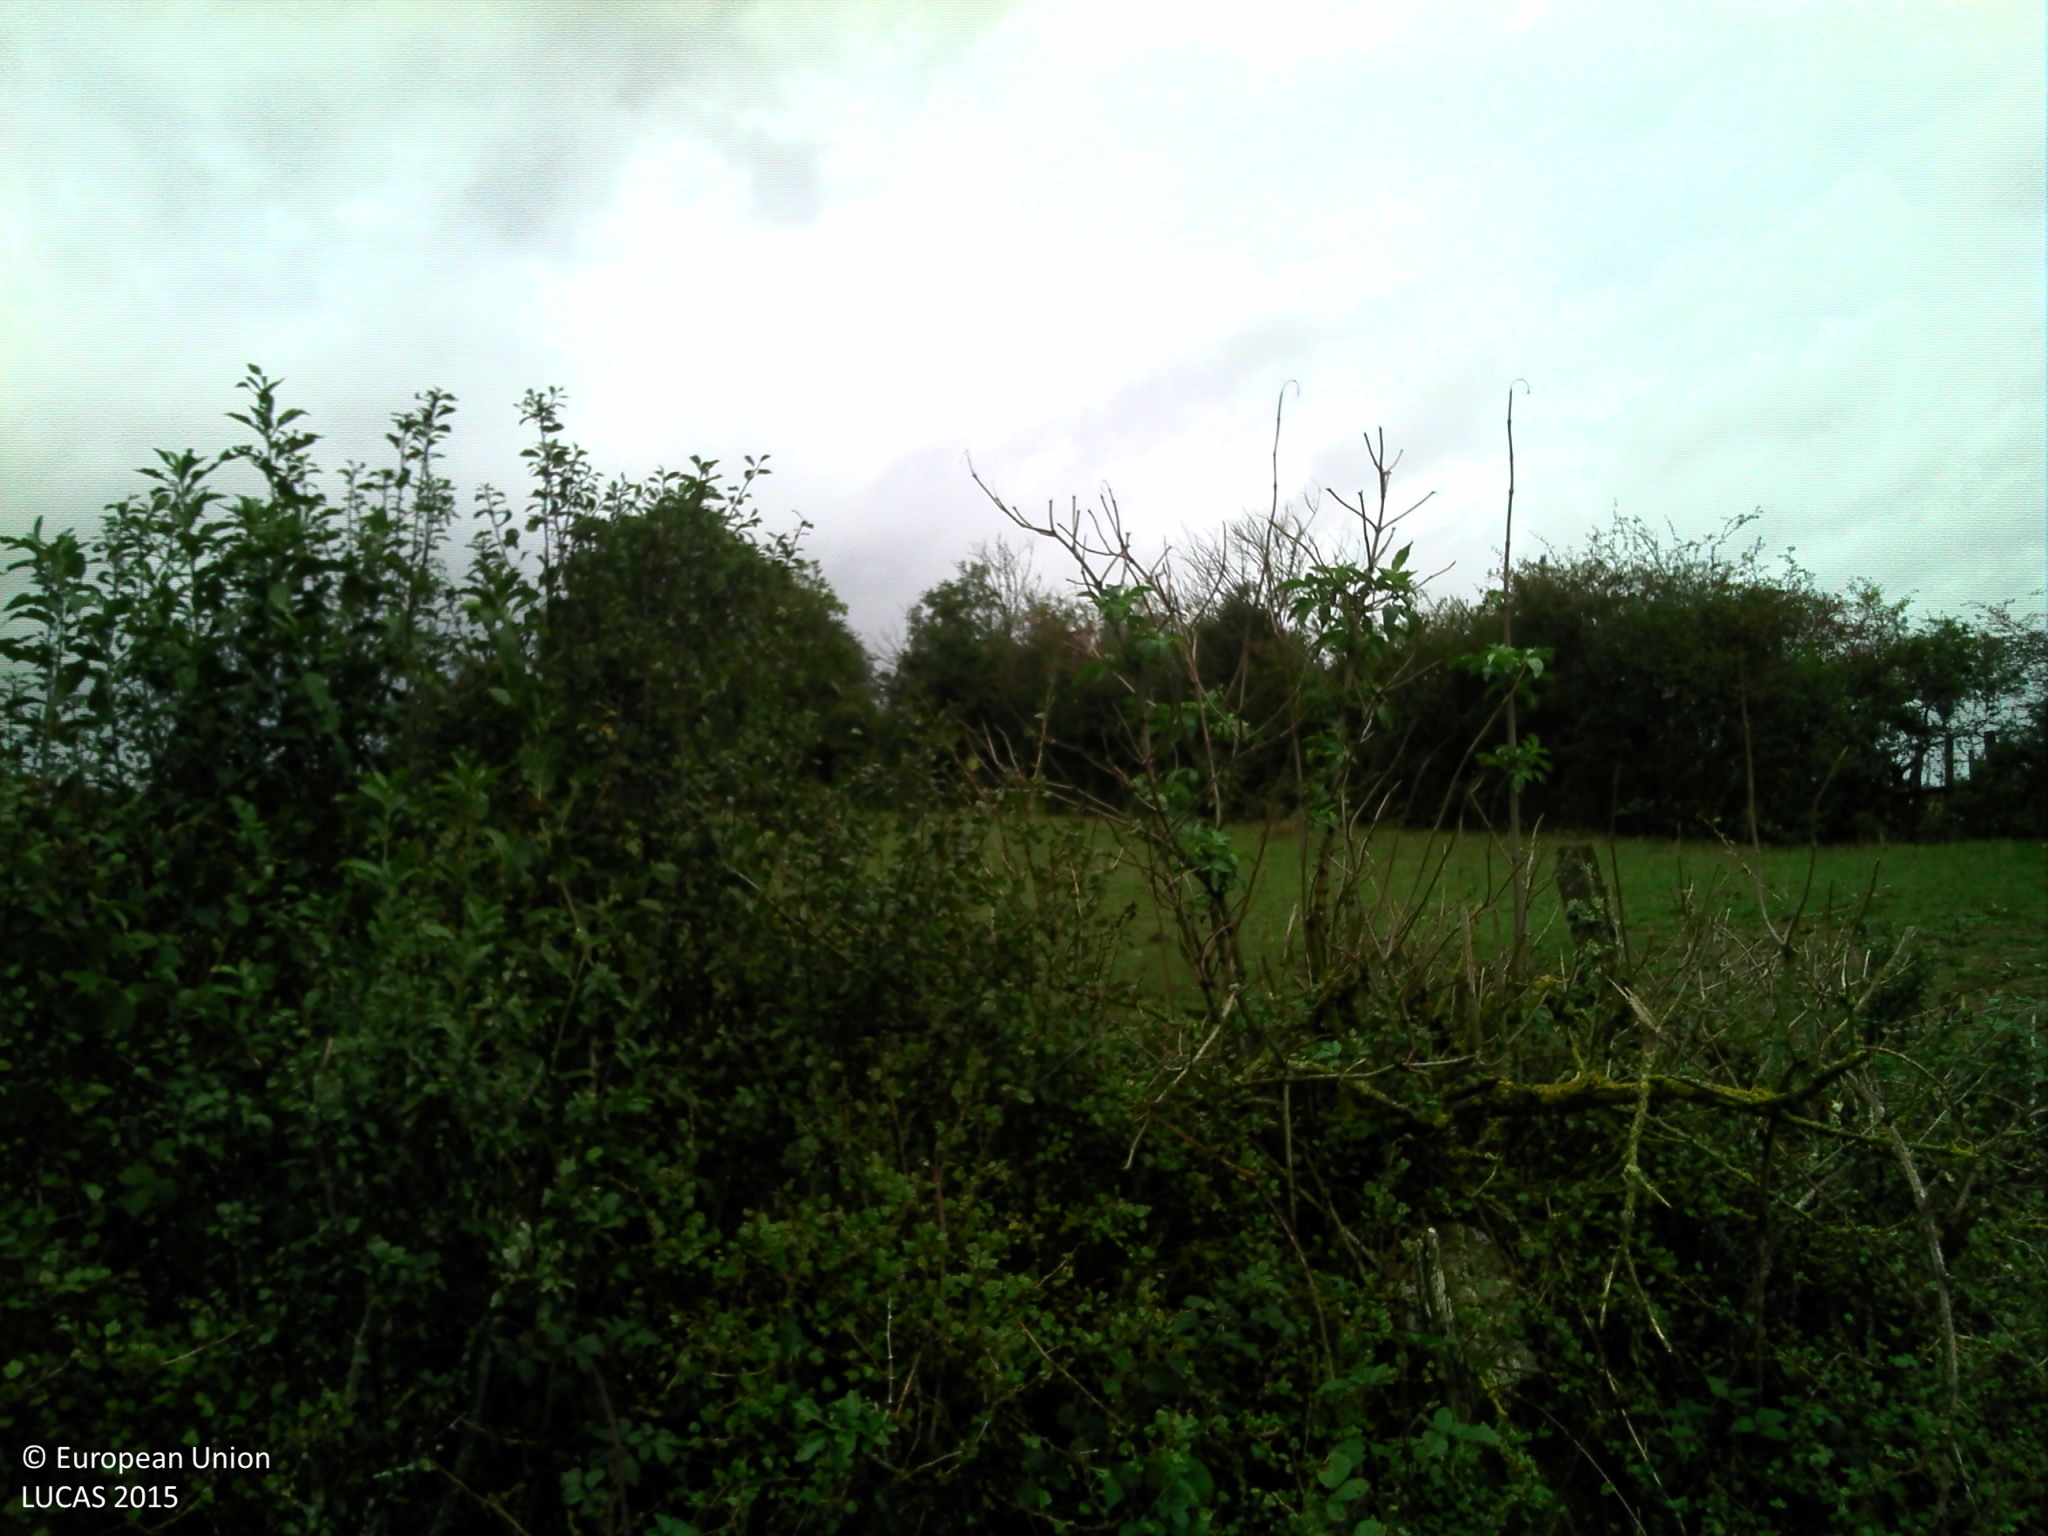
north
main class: Grassland
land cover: Grassland without tree/shrub cover
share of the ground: > 75 %
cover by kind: herbaceous plants 100 %
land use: Agriculture (excluding fallow land and kitchen gardens)
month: September
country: FR
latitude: 47.3554
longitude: 4.3194
